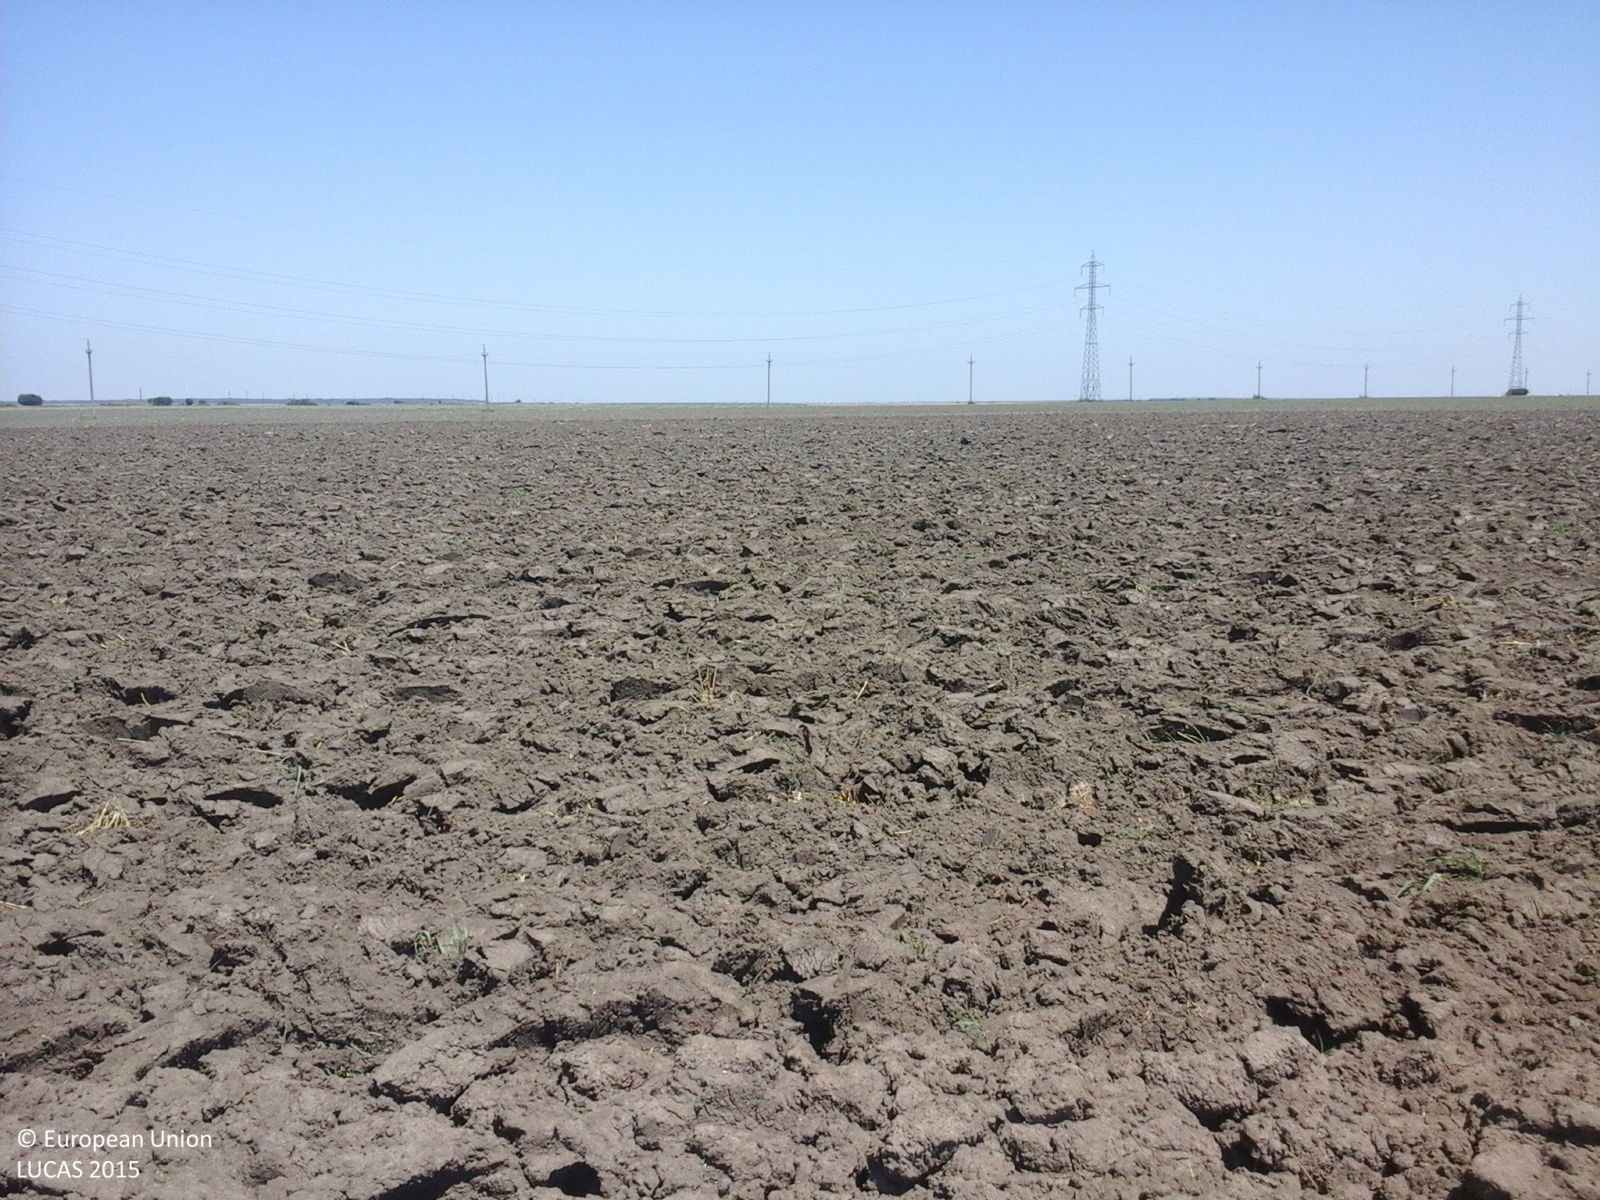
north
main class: Cropland
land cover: Durum wheat
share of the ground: < 10 %
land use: Agriculture (excluding fallow land and kitchen gardens)
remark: Harvested field
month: July
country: RO
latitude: 44.1295
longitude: 26.6762
